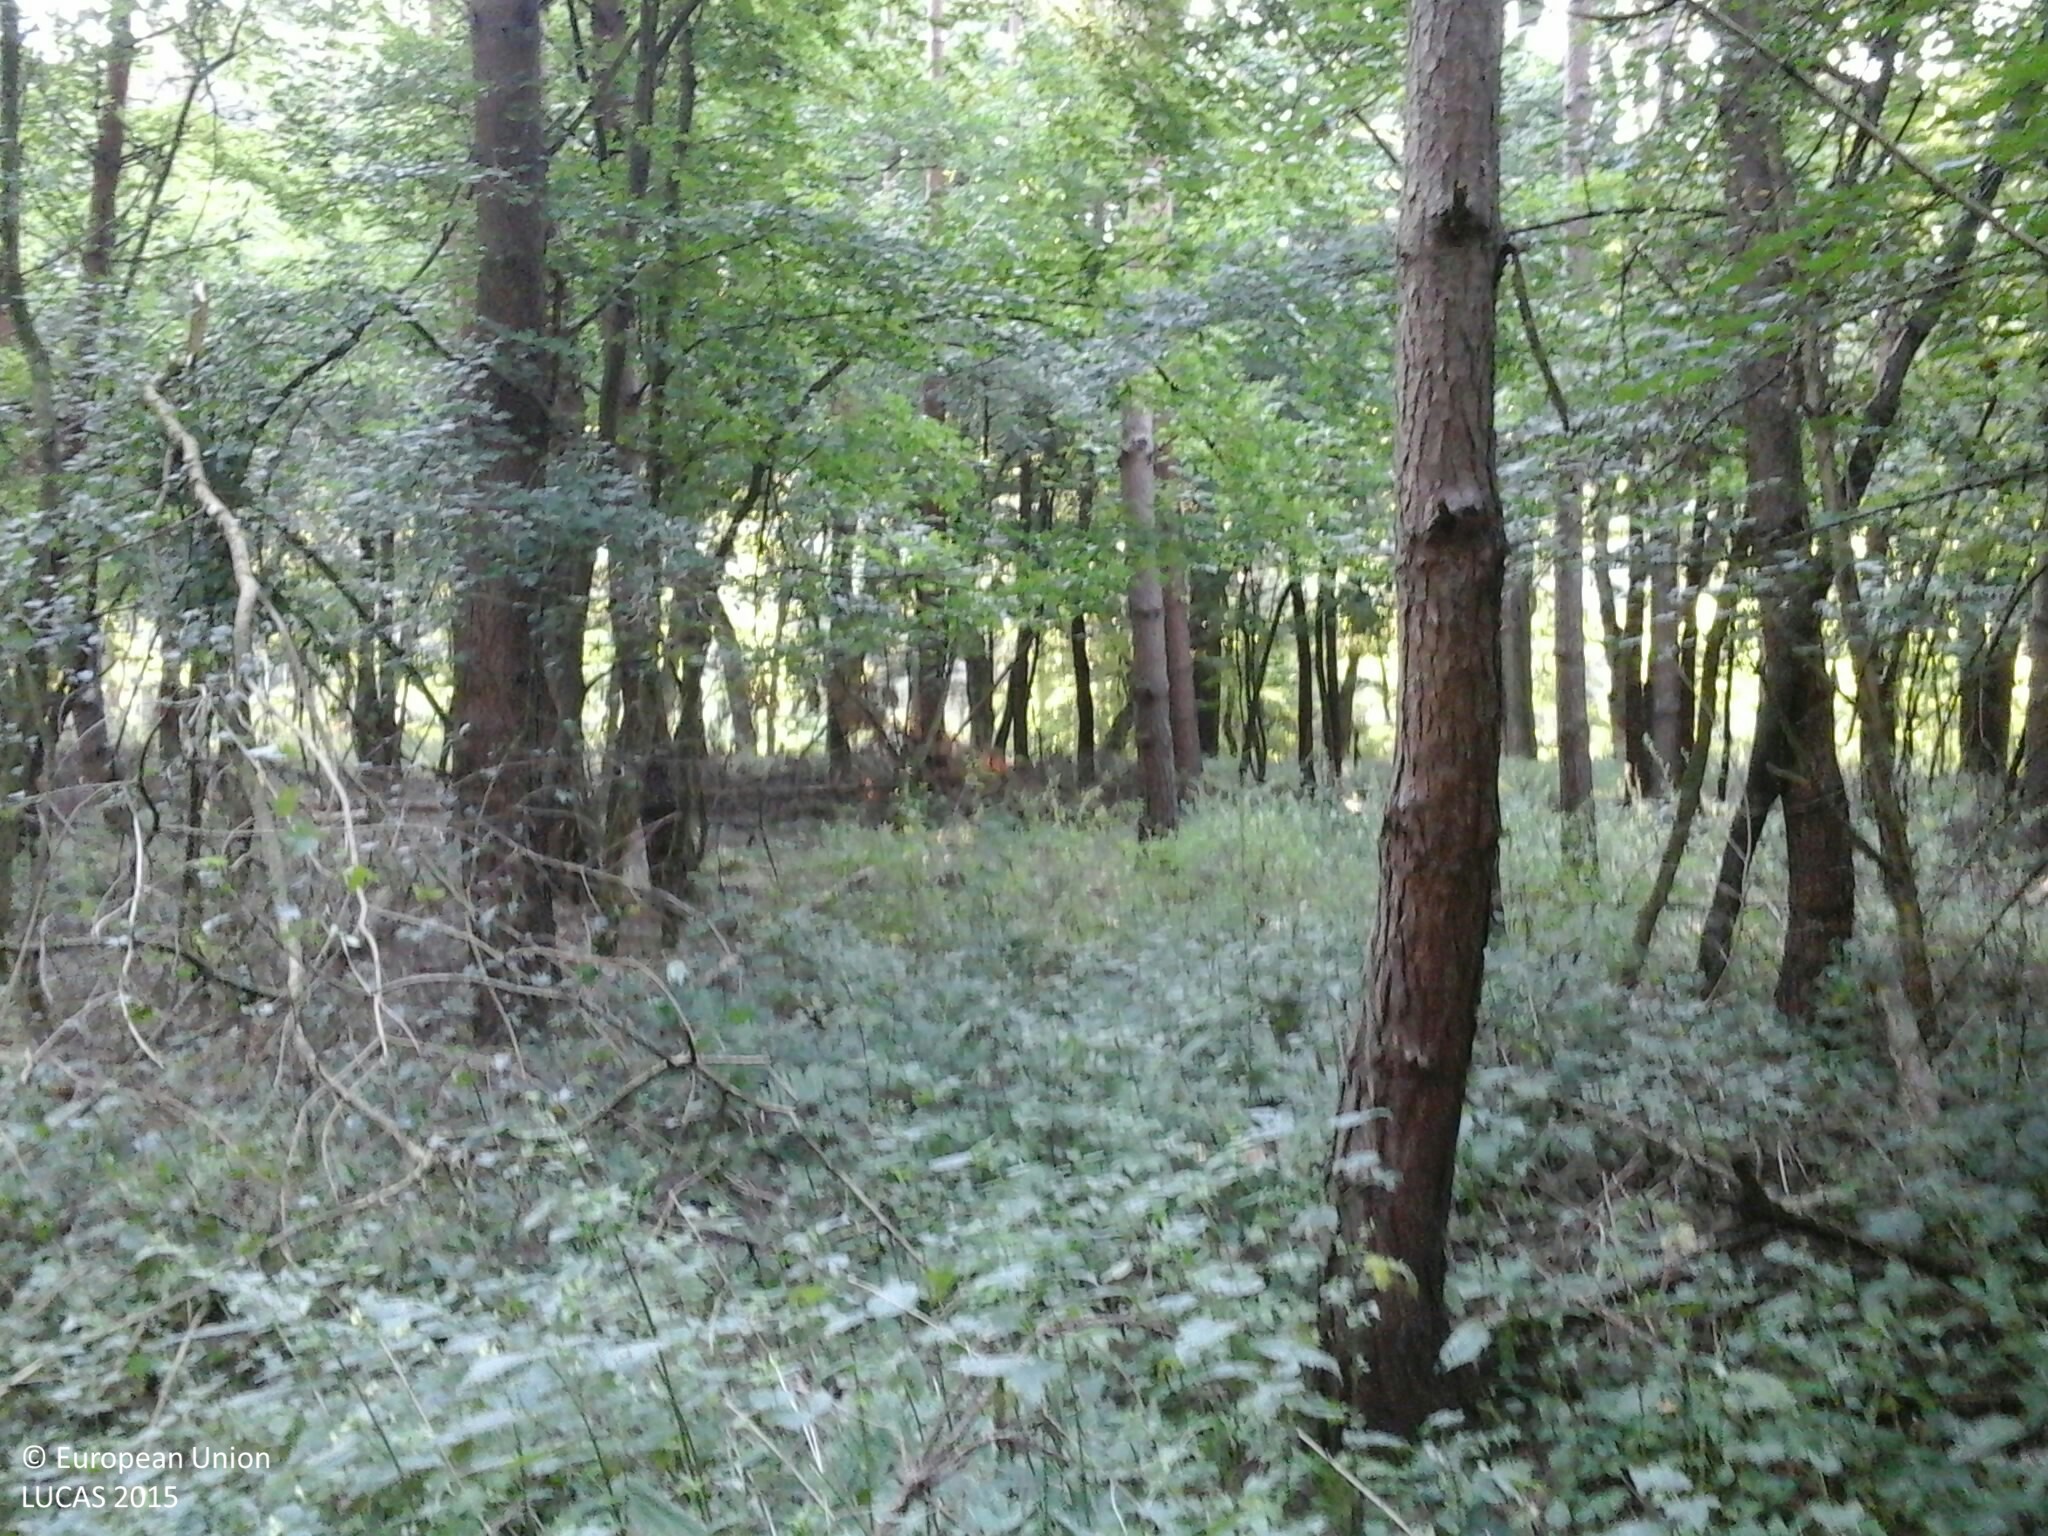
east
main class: Woodland
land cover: Pine dominated mixed woodland
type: hemiboreal forest and nemoral coniferous forest and mixed broadleaved-coniferous forest
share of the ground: > 75 %
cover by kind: coniferous forest trees 60 %, broadleaved forest trees 20 %, shrubs 15 %, herbaceous plants 5 %
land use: Forestry
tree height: > 5 m
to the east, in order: Pine dominated mixed woodland; Pine dominated coniferous woodland; Broadleaved woodland; Rivers and streams; Spruce dominated coniferous woodland; Pine dominated mixed woodland; Tracks; Ditches and canals; Pine dominated mixed woodland
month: August
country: HU
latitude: 47.1662
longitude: 16.4802
